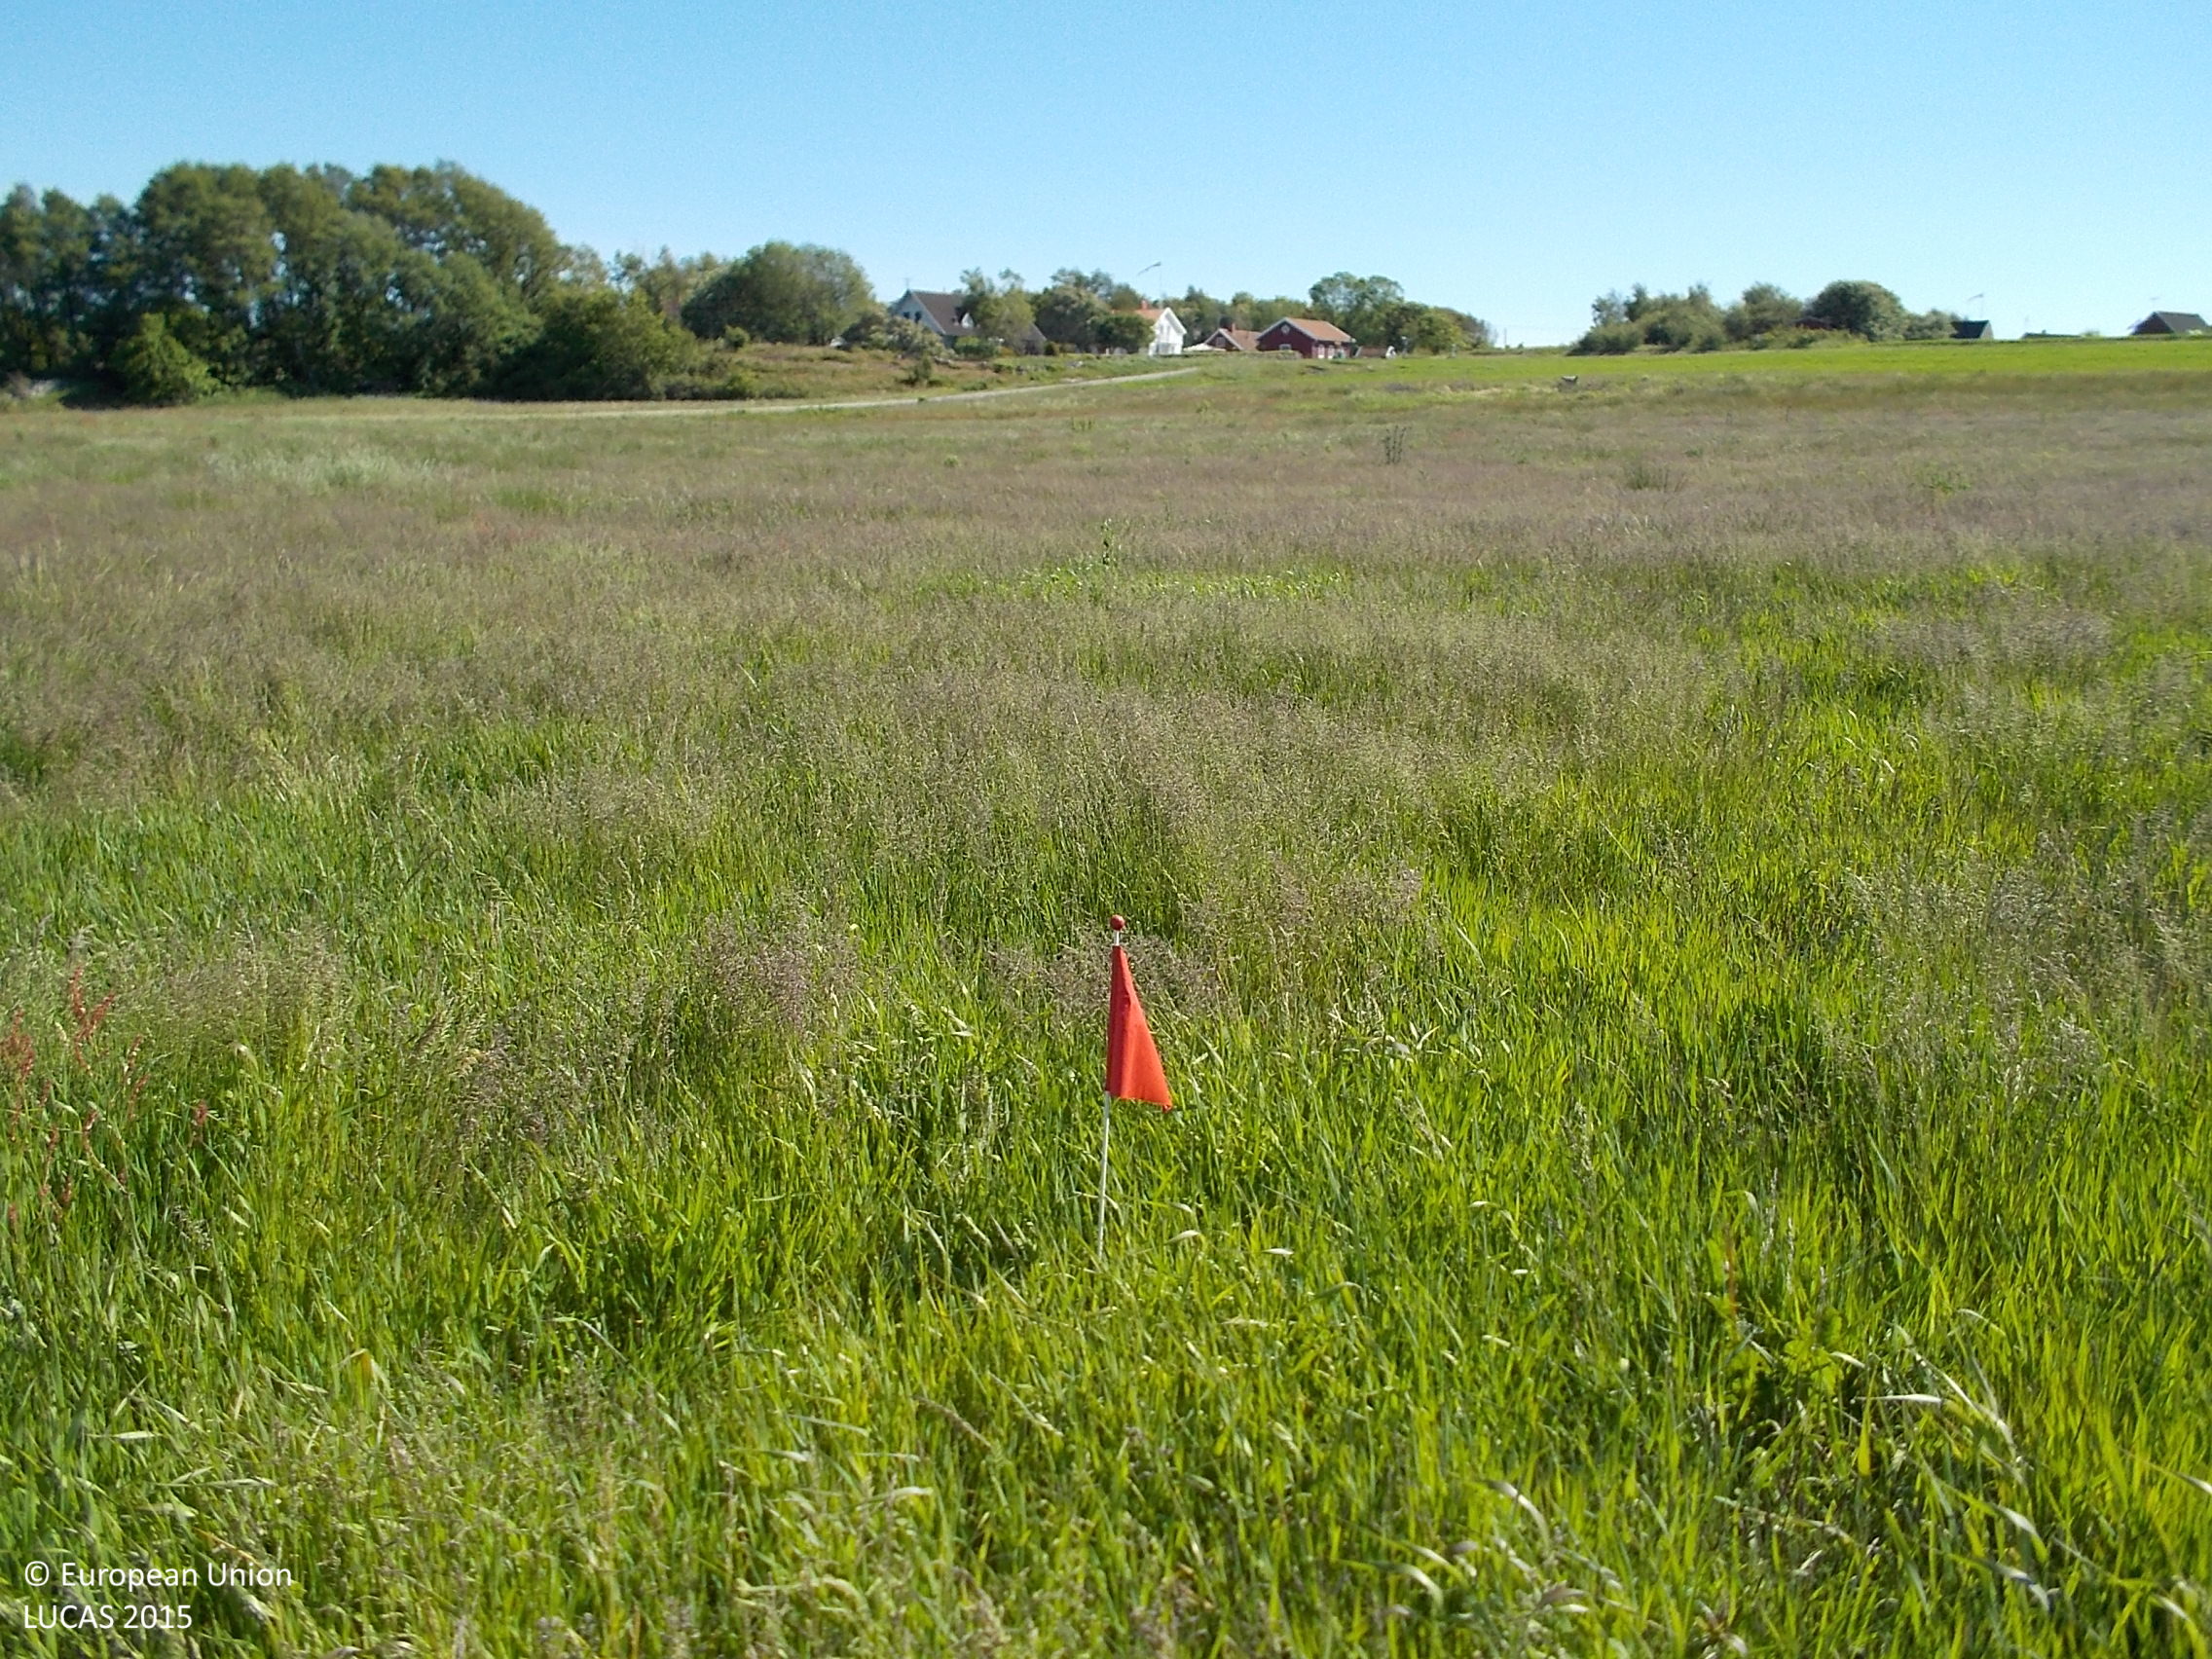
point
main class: Grassland
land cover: Grassland without tree/shrub cover
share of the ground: > 75 %
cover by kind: herbaceous plants 100 %
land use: Agriculture (excluding fallow land and kitchen gardens)
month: June
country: SE
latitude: 57.2311
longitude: 12.1339
